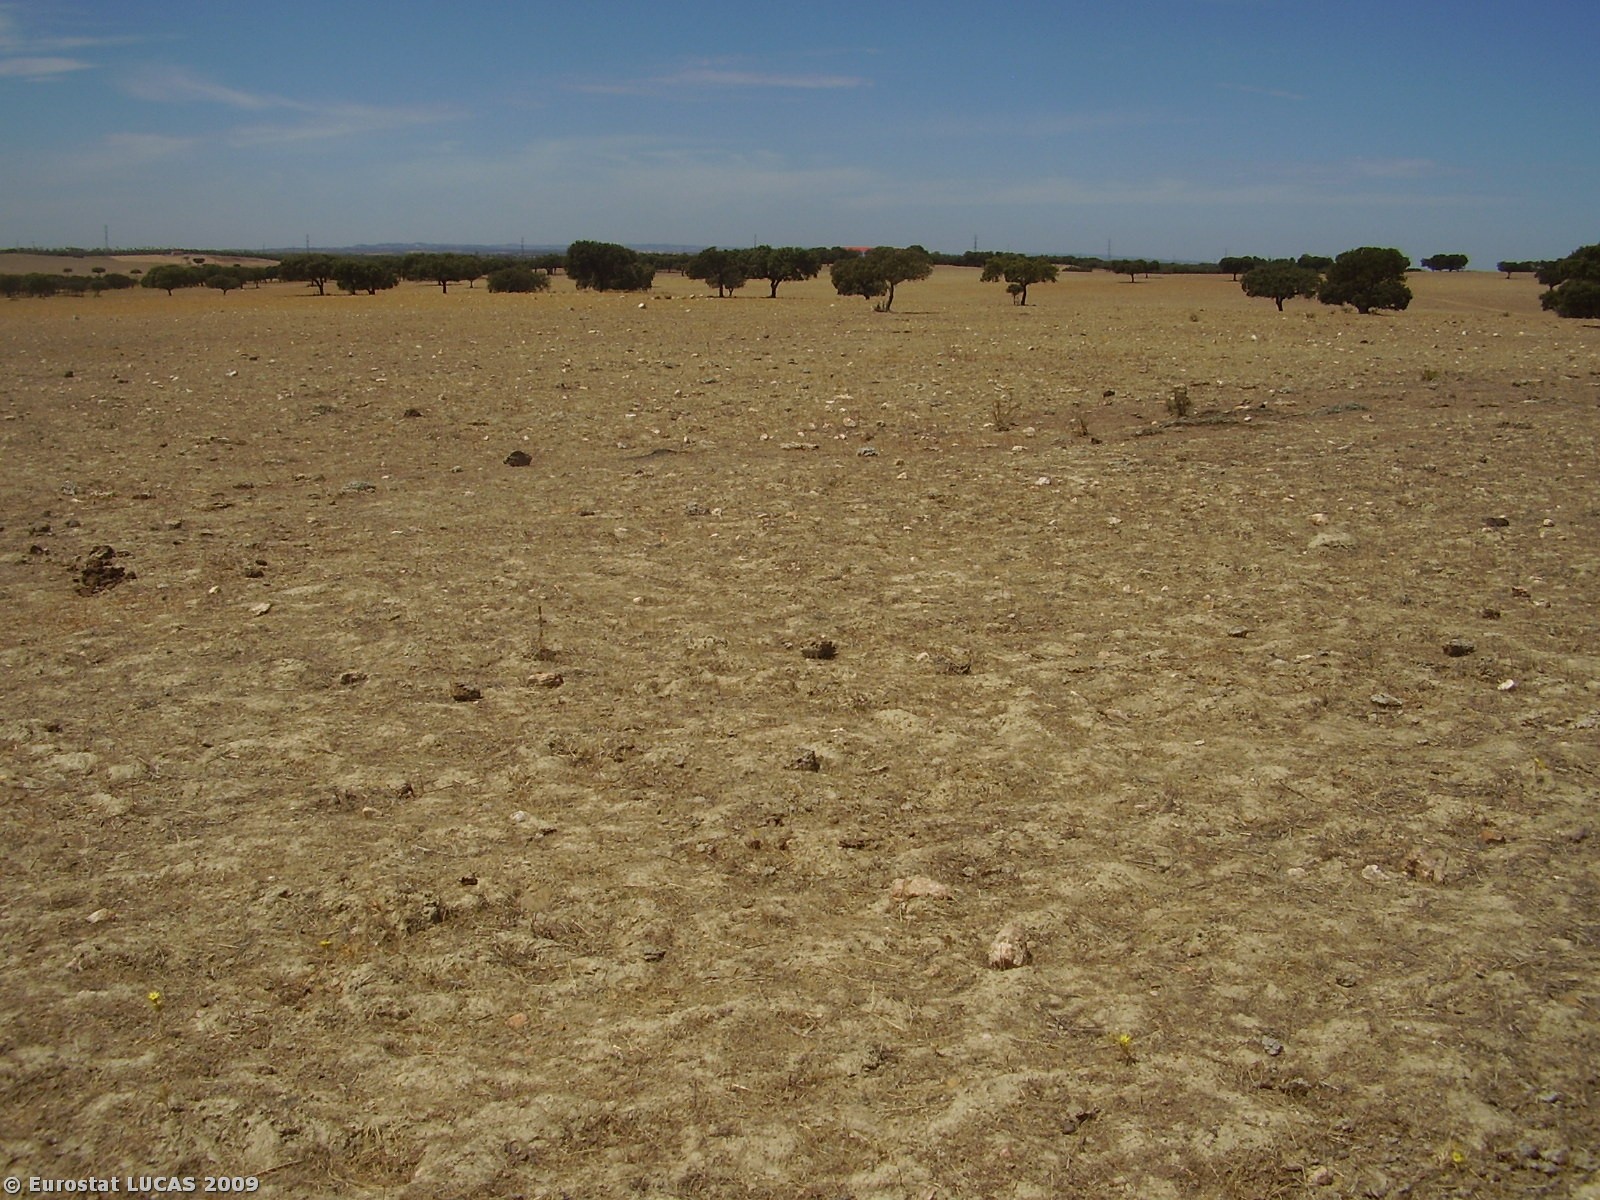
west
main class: Grassland
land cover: Grassland with sparse tree/shrub cover
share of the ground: > 75 %
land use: Fallow land
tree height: > 5 m
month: August
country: PT
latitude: 38.2255
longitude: -7.1621
